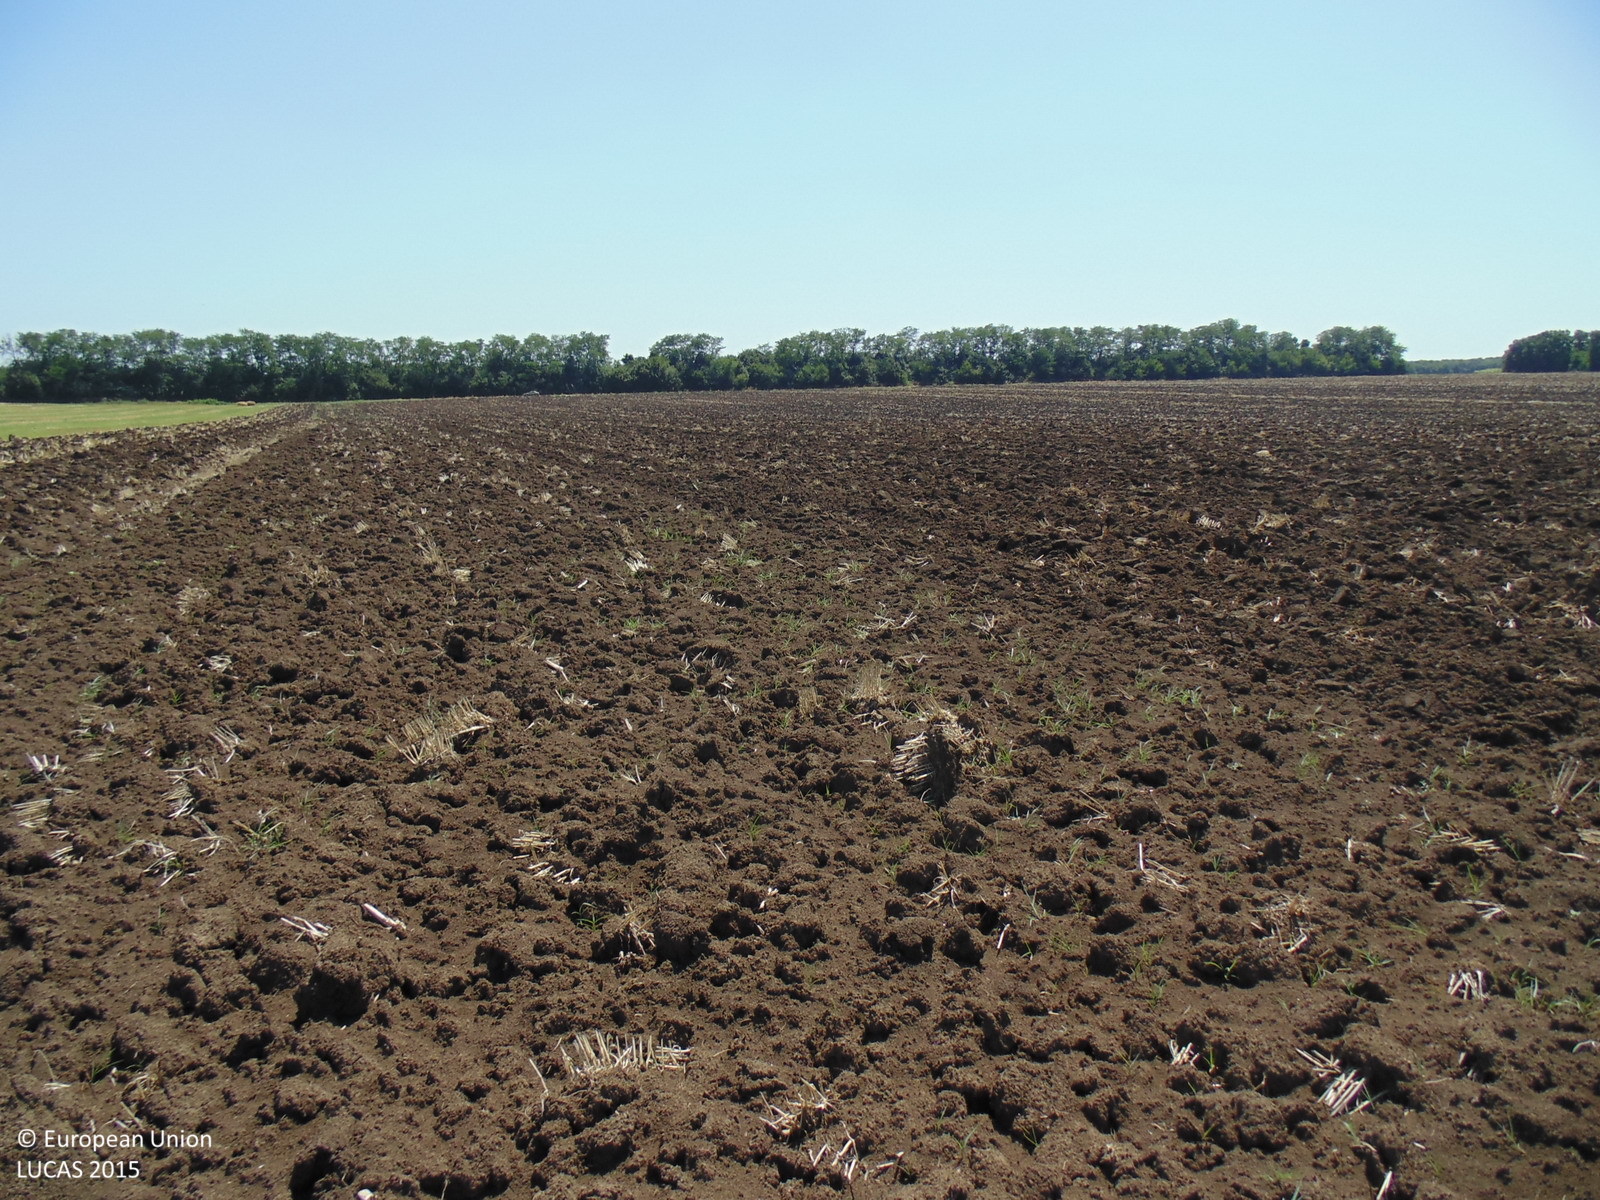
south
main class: Cropland
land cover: Common wheat
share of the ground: < 10 %
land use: Agriculture (excluding fallow land and kitchen gardens)
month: August
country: BG
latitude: 43.4827
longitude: 28.1901
